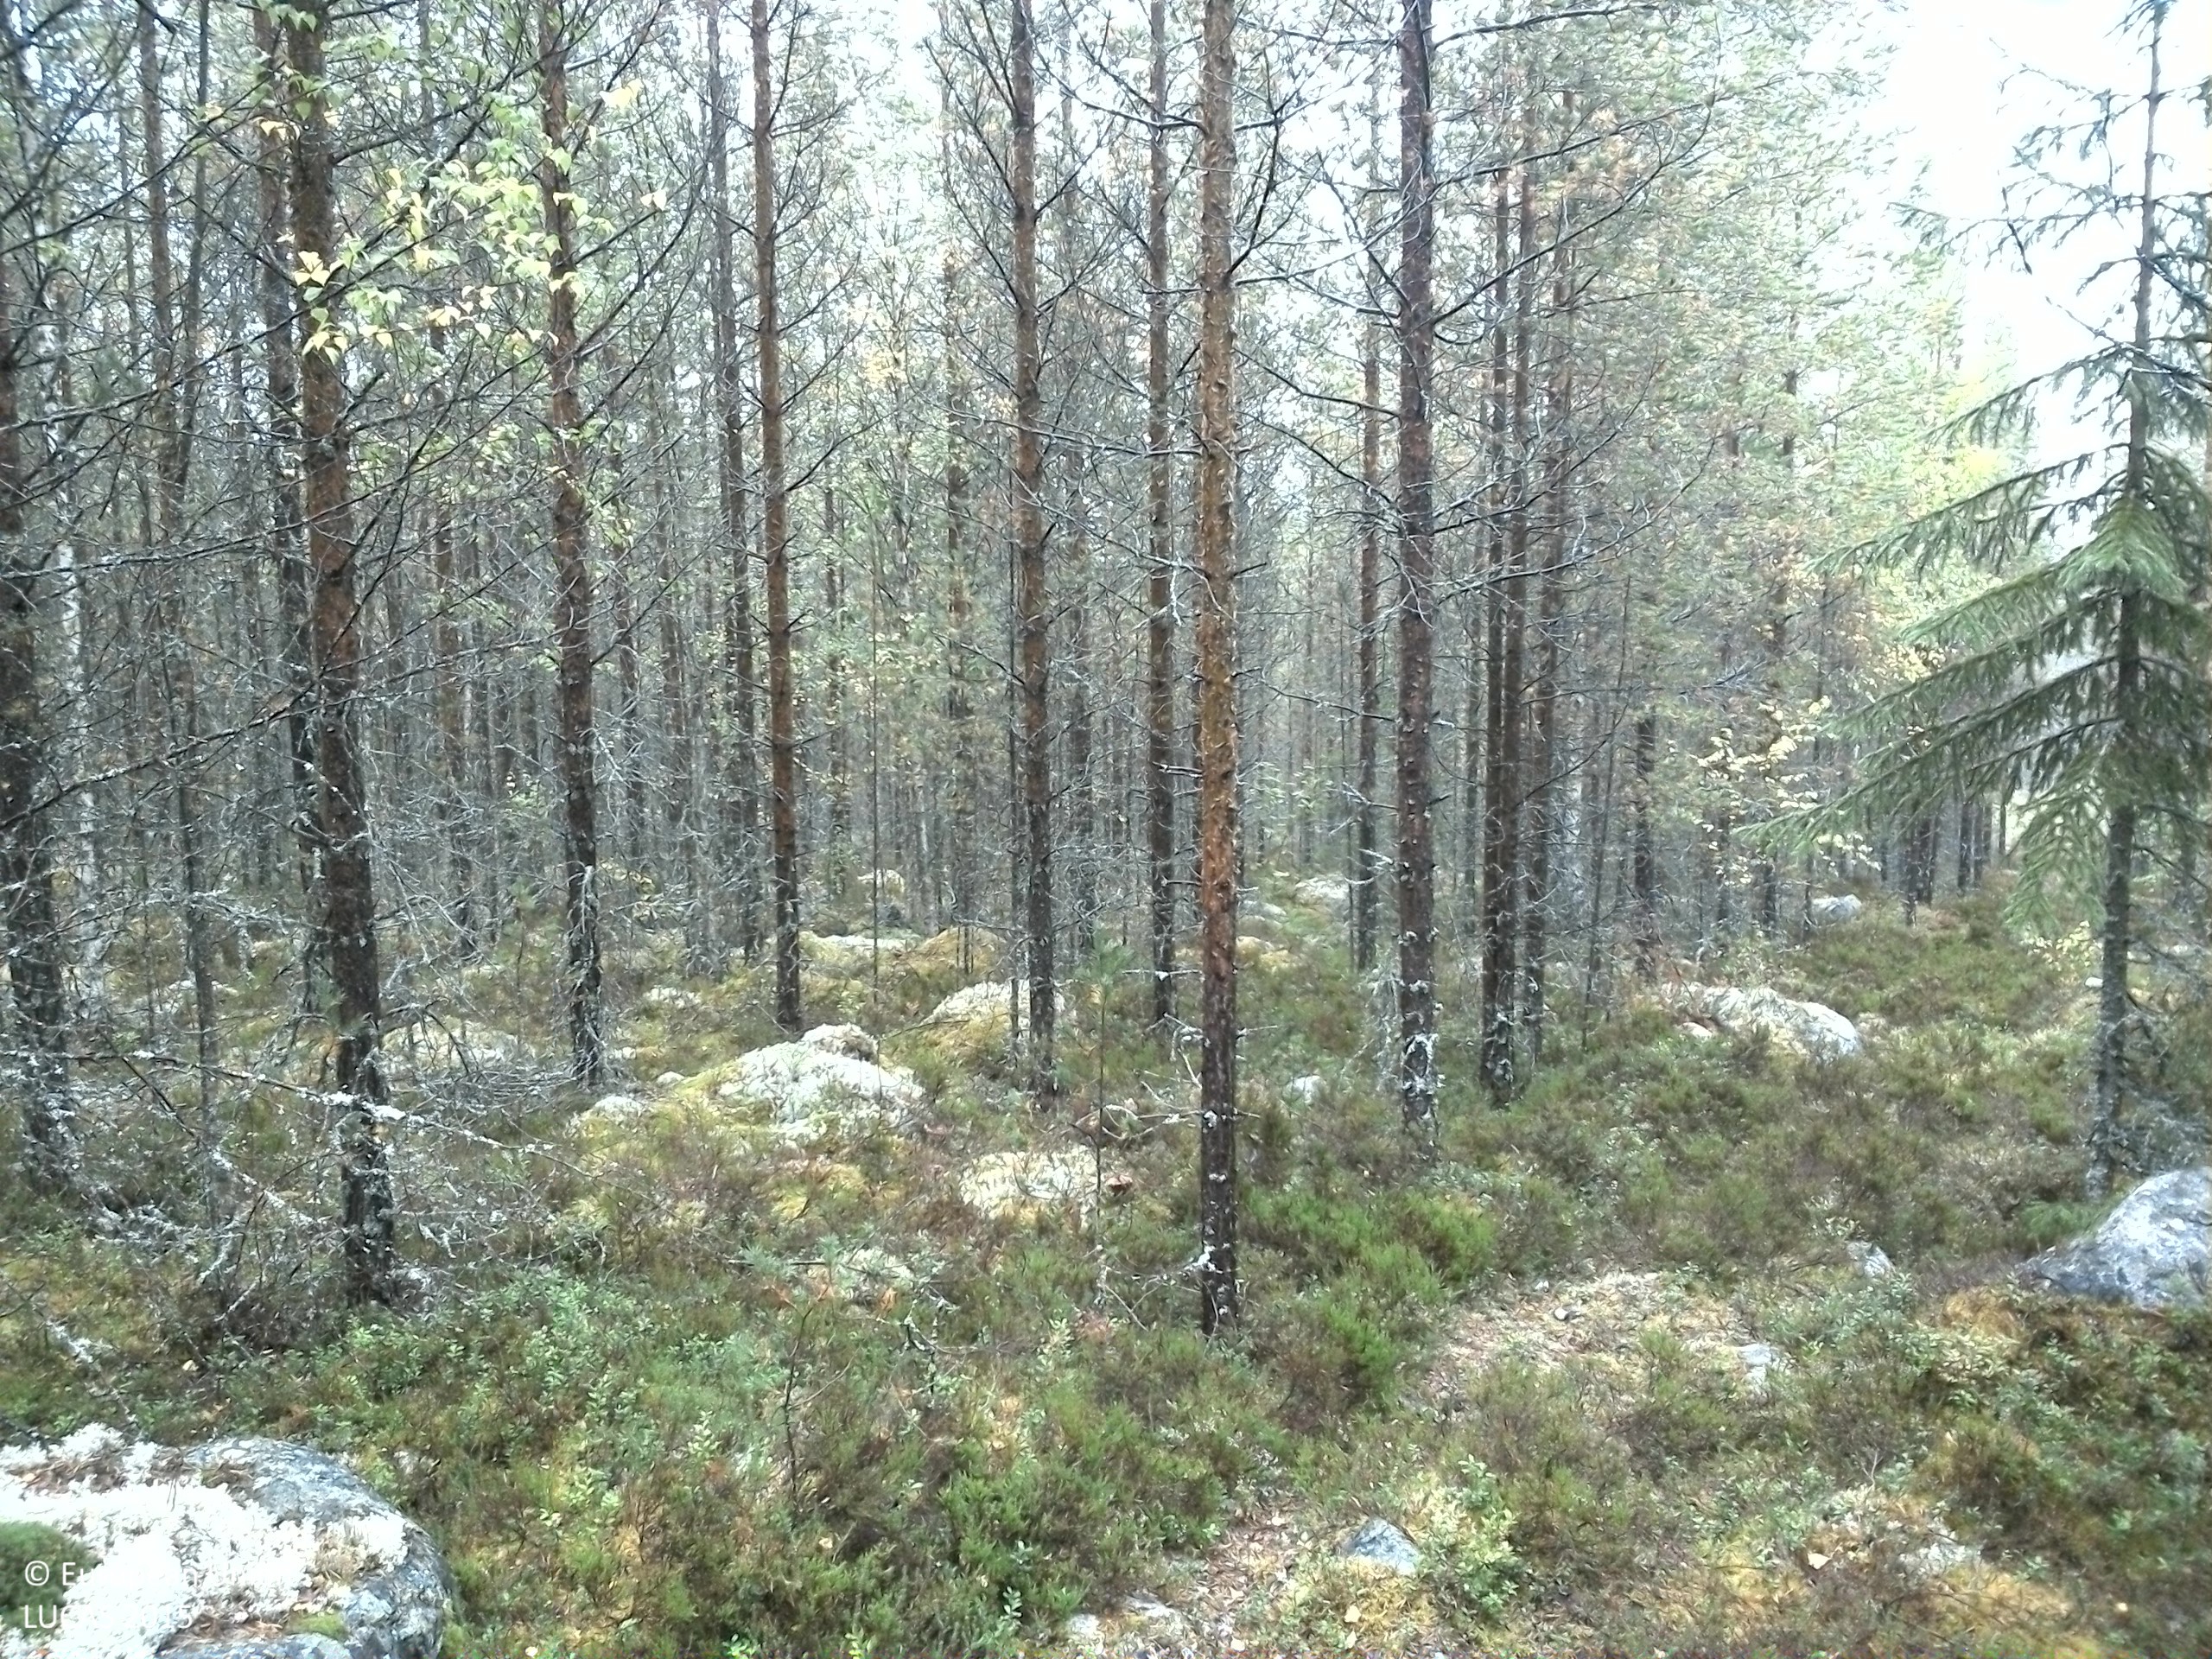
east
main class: Woodland
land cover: Pine dominated coniferous woodland
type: boreal forest
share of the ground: > 75 %
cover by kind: coniferous forest trees 75 %, shrubs 10 %, lichens and mosses 10 %, broadleaved forest trees 5 %
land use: Forestry
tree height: > 5 m
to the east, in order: Pine dominated coniferous woodland; Pine dominated mixed woodland; Tracks; Other mixed woodland; Spruce dominated mixed woodland
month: September
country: SE
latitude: 61.5126
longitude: 15.1526
